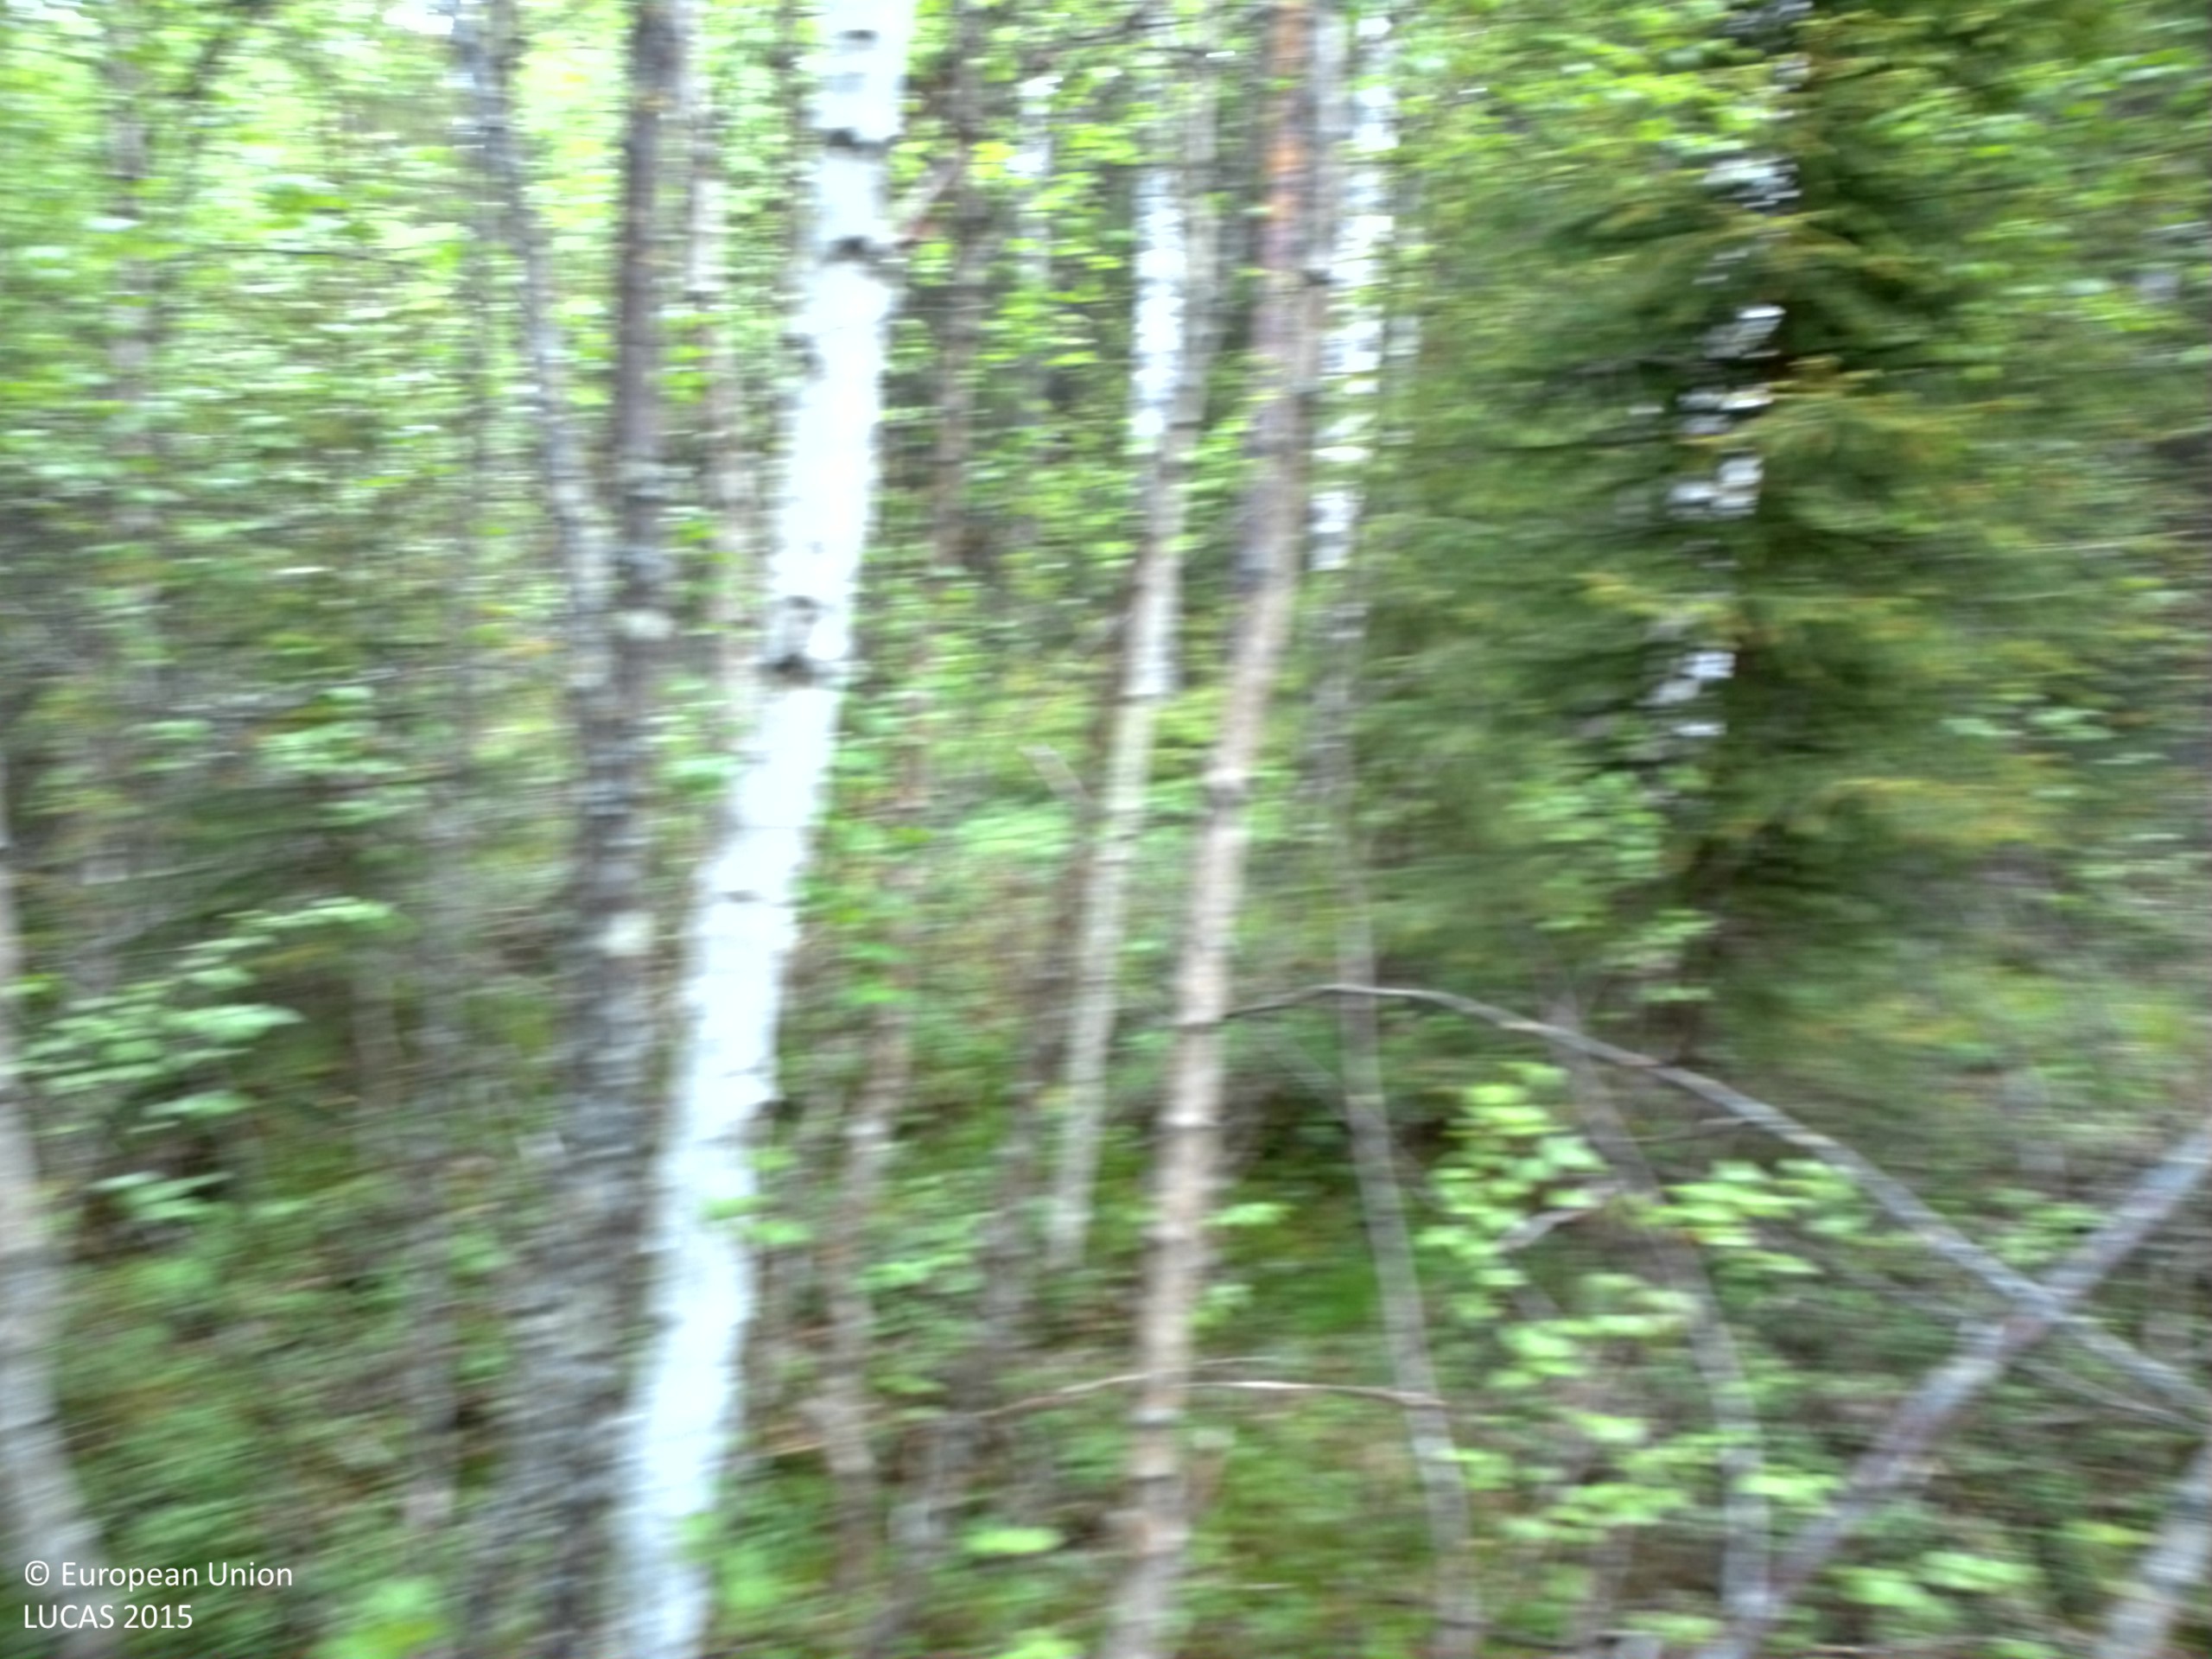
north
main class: Woodland
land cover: Broadleaved woodland
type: boreal forest
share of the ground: > 75 %
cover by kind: broadleaved forest trees 80 %, coniferous forest trees 10 %, herbaceous plants 10 %
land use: Forestry
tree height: > 5 m
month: June
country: SE
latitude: 63.1403
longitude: 17.3363
